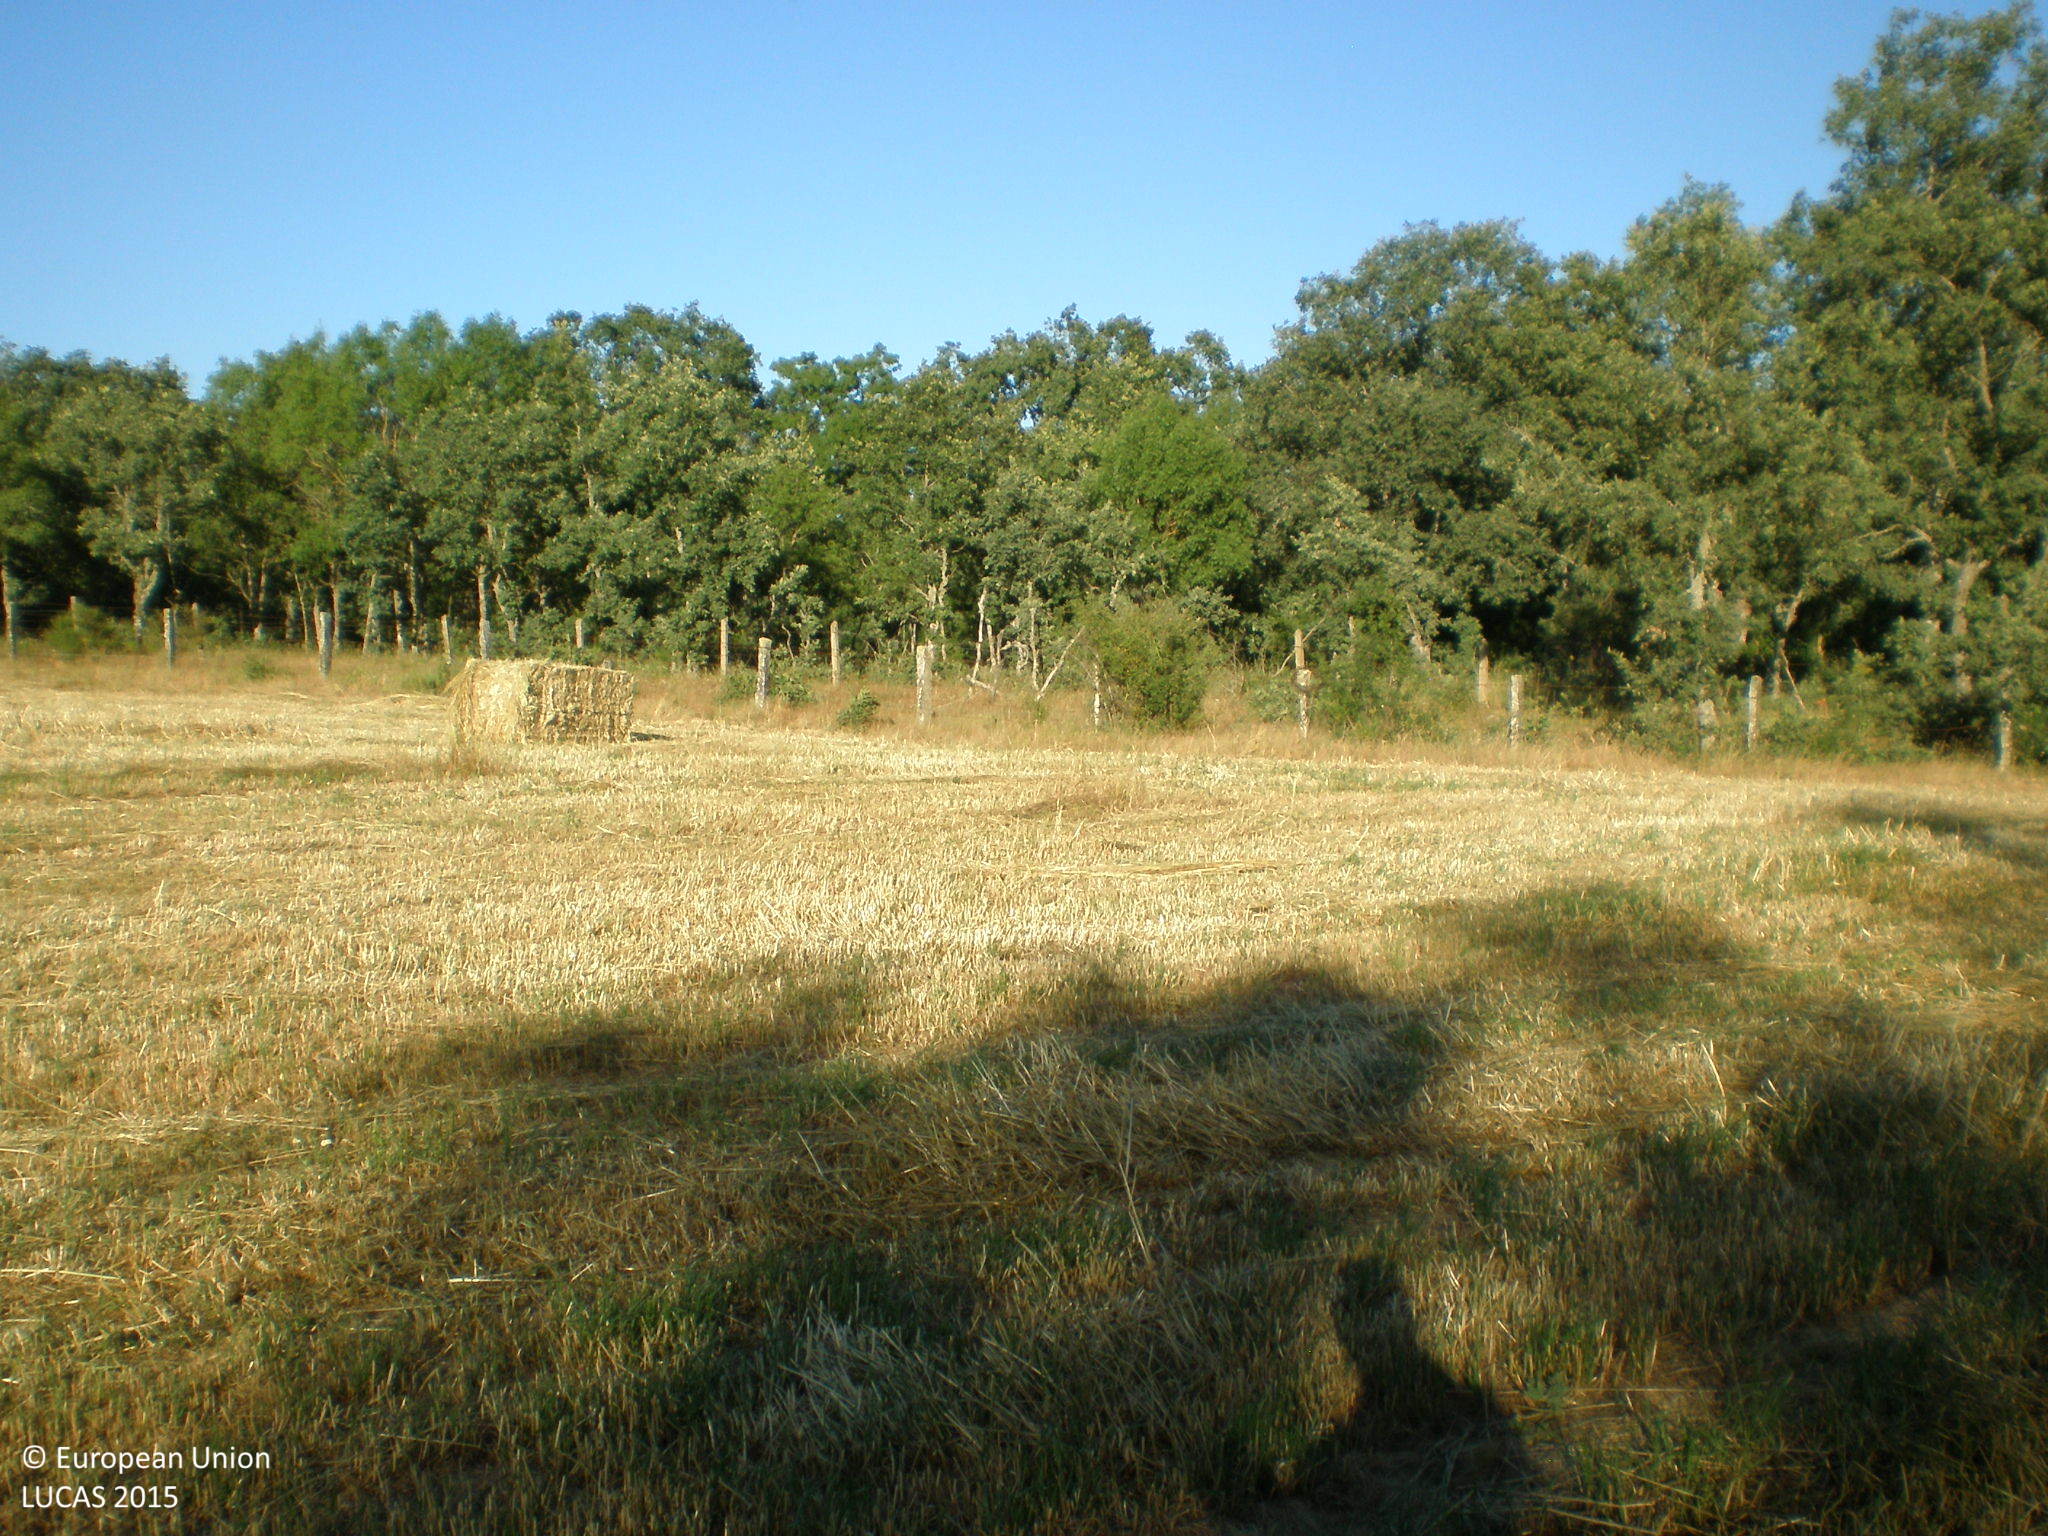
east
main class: Cropland
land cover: Mixed cereals for fodder
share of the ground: < 10 %
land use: Agriculture (excluding fallow land and kitchen gardens)
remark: Harvested field
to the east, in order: Mixed cereals for fodder; Fences; Grass margins; Tracks; Grass margins; Fences; Broadleaved woodland; Dry stone walls; Grassland with sparse tree/shrub cover; Broadleaved woodland; Dry stone walls; Broadleaved woodland
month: June
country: ES
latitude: 40.5744
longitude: -5.8211
